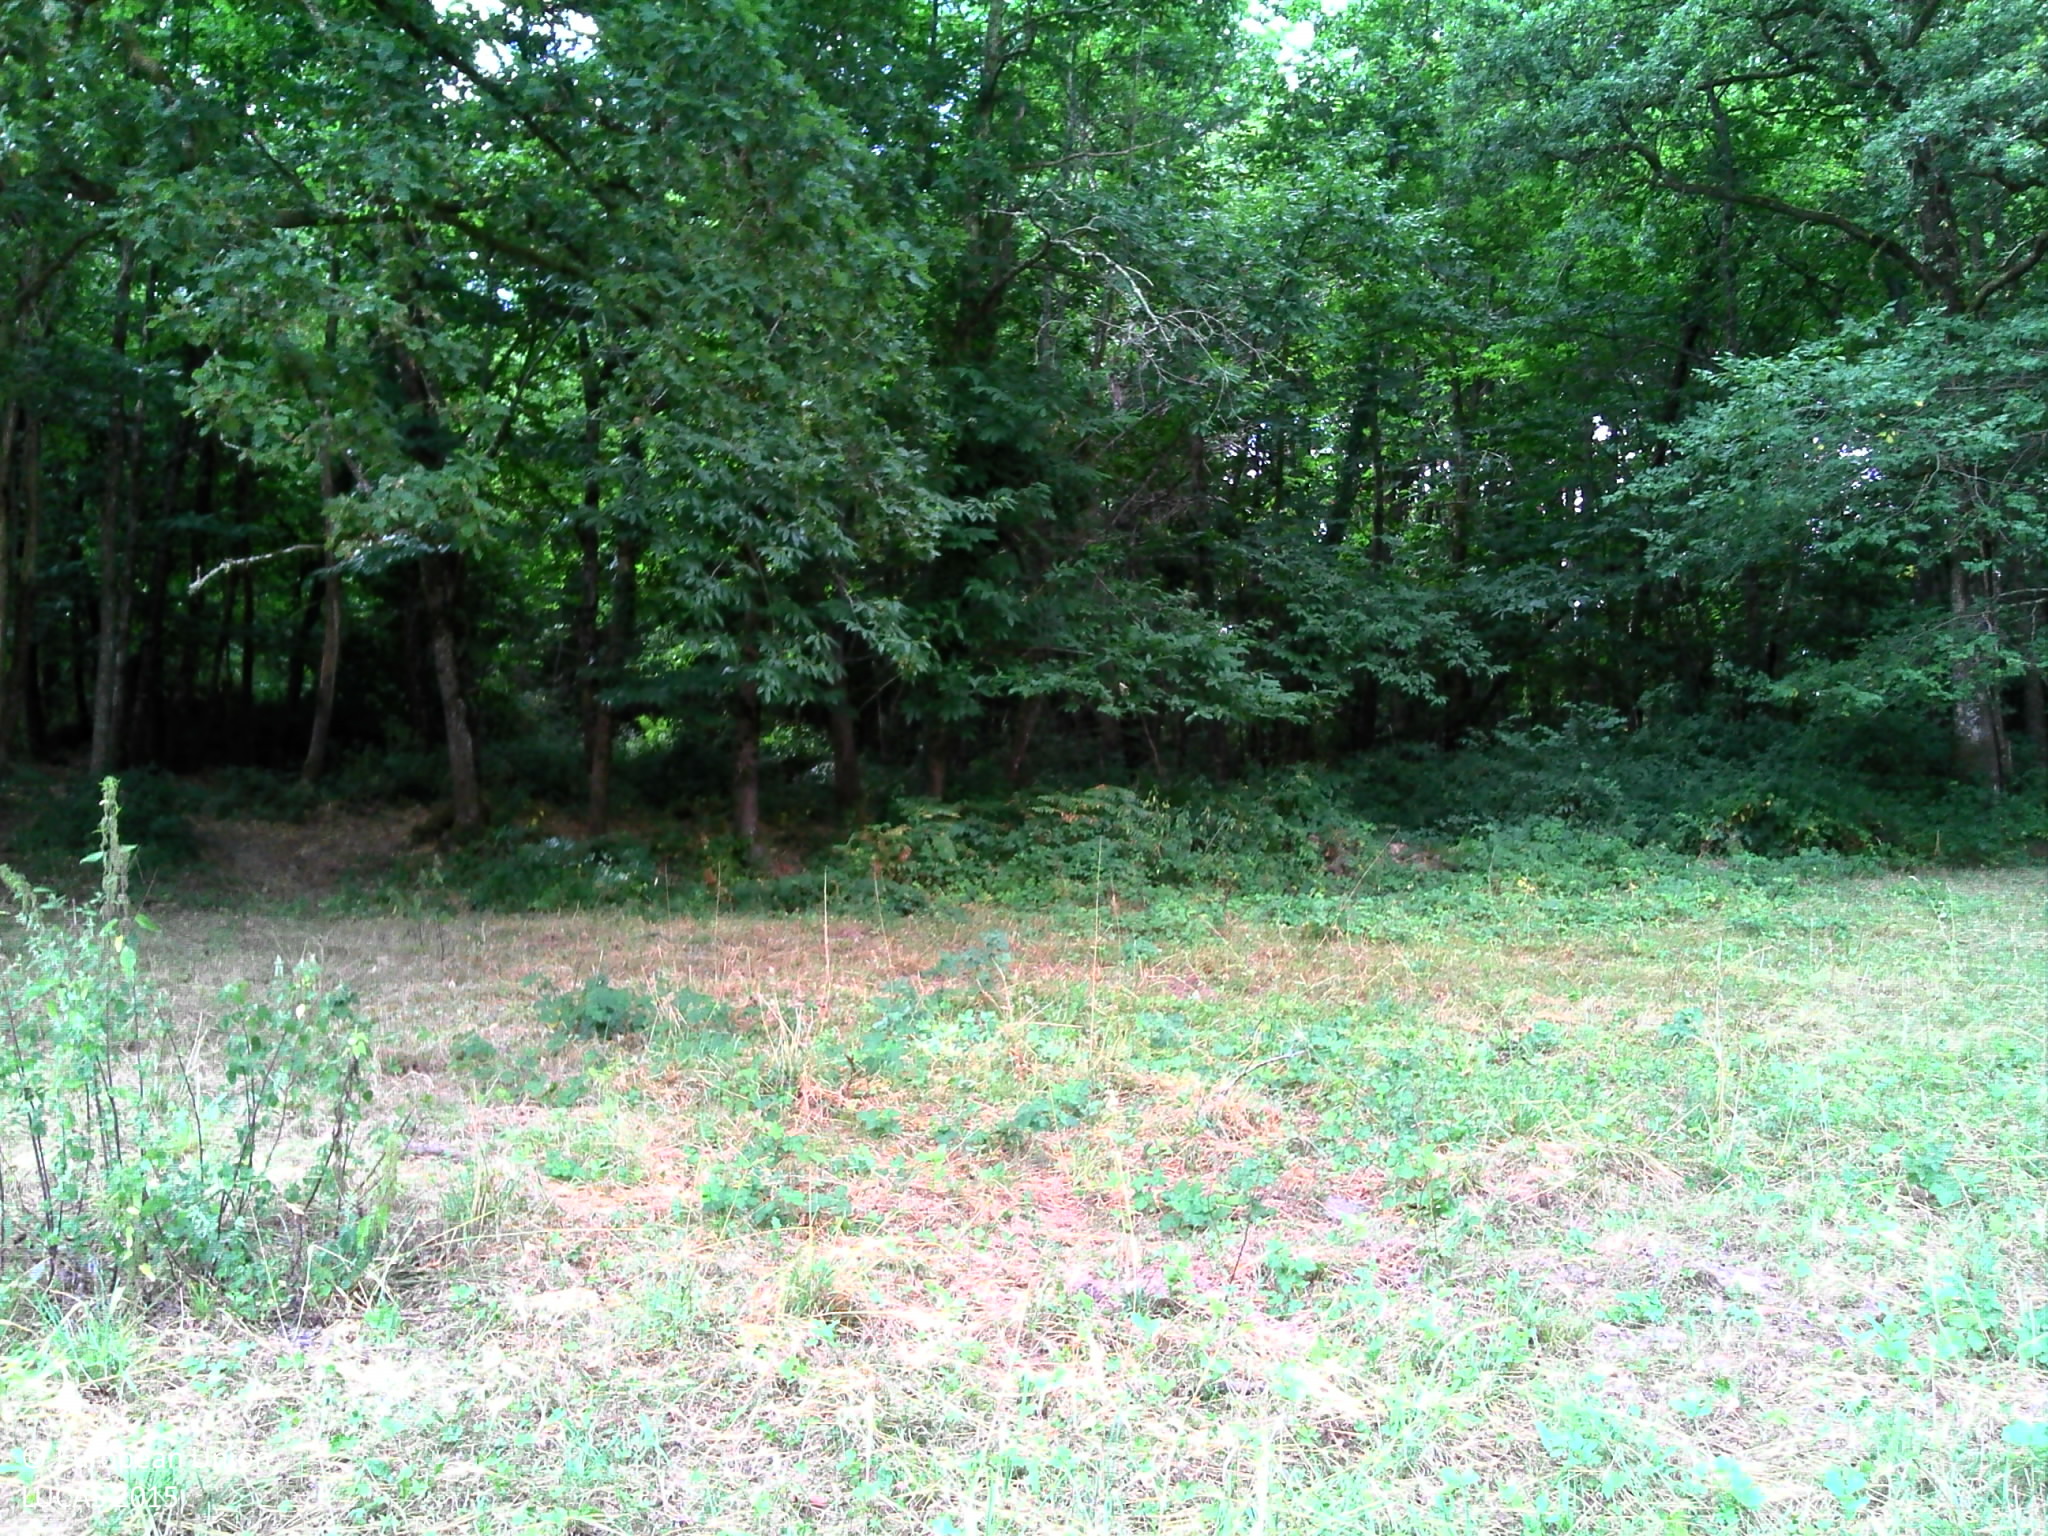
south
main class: Grassland
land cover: Grassland without tree/shrub cover
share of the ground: > 75 %
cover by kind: herbaceous plants 95 %, lichens and mosses 5 %
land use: Agriculture (excluding fallow land and kitchen gardens)
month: July
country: FR
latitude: 45.0217
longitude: 0.9185
